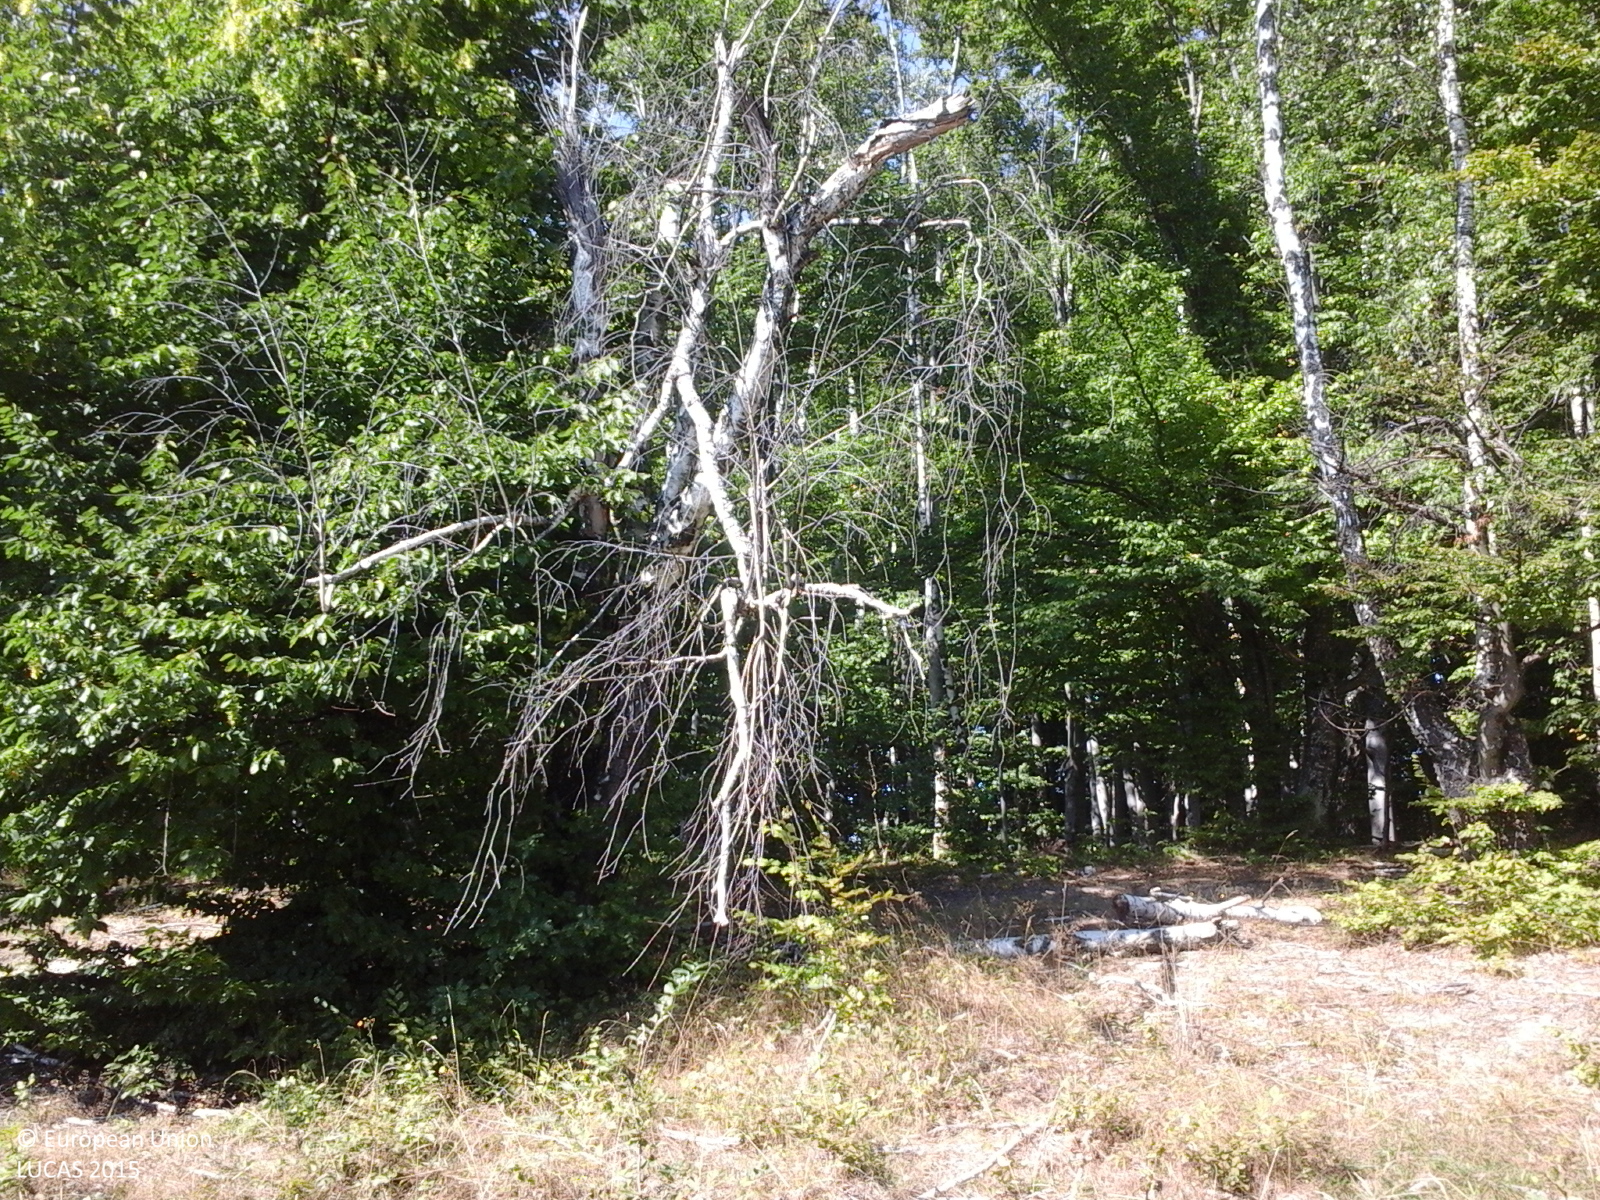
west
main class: Woodland
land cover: Broadleaved woodland
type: broadleaved evergreen forest
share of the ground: > 75 %
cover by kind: broadleaved forest trees 100 %
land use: Forestry
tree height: > 5 m
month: September
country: RO
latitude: 47.1665
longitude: 22.4685
